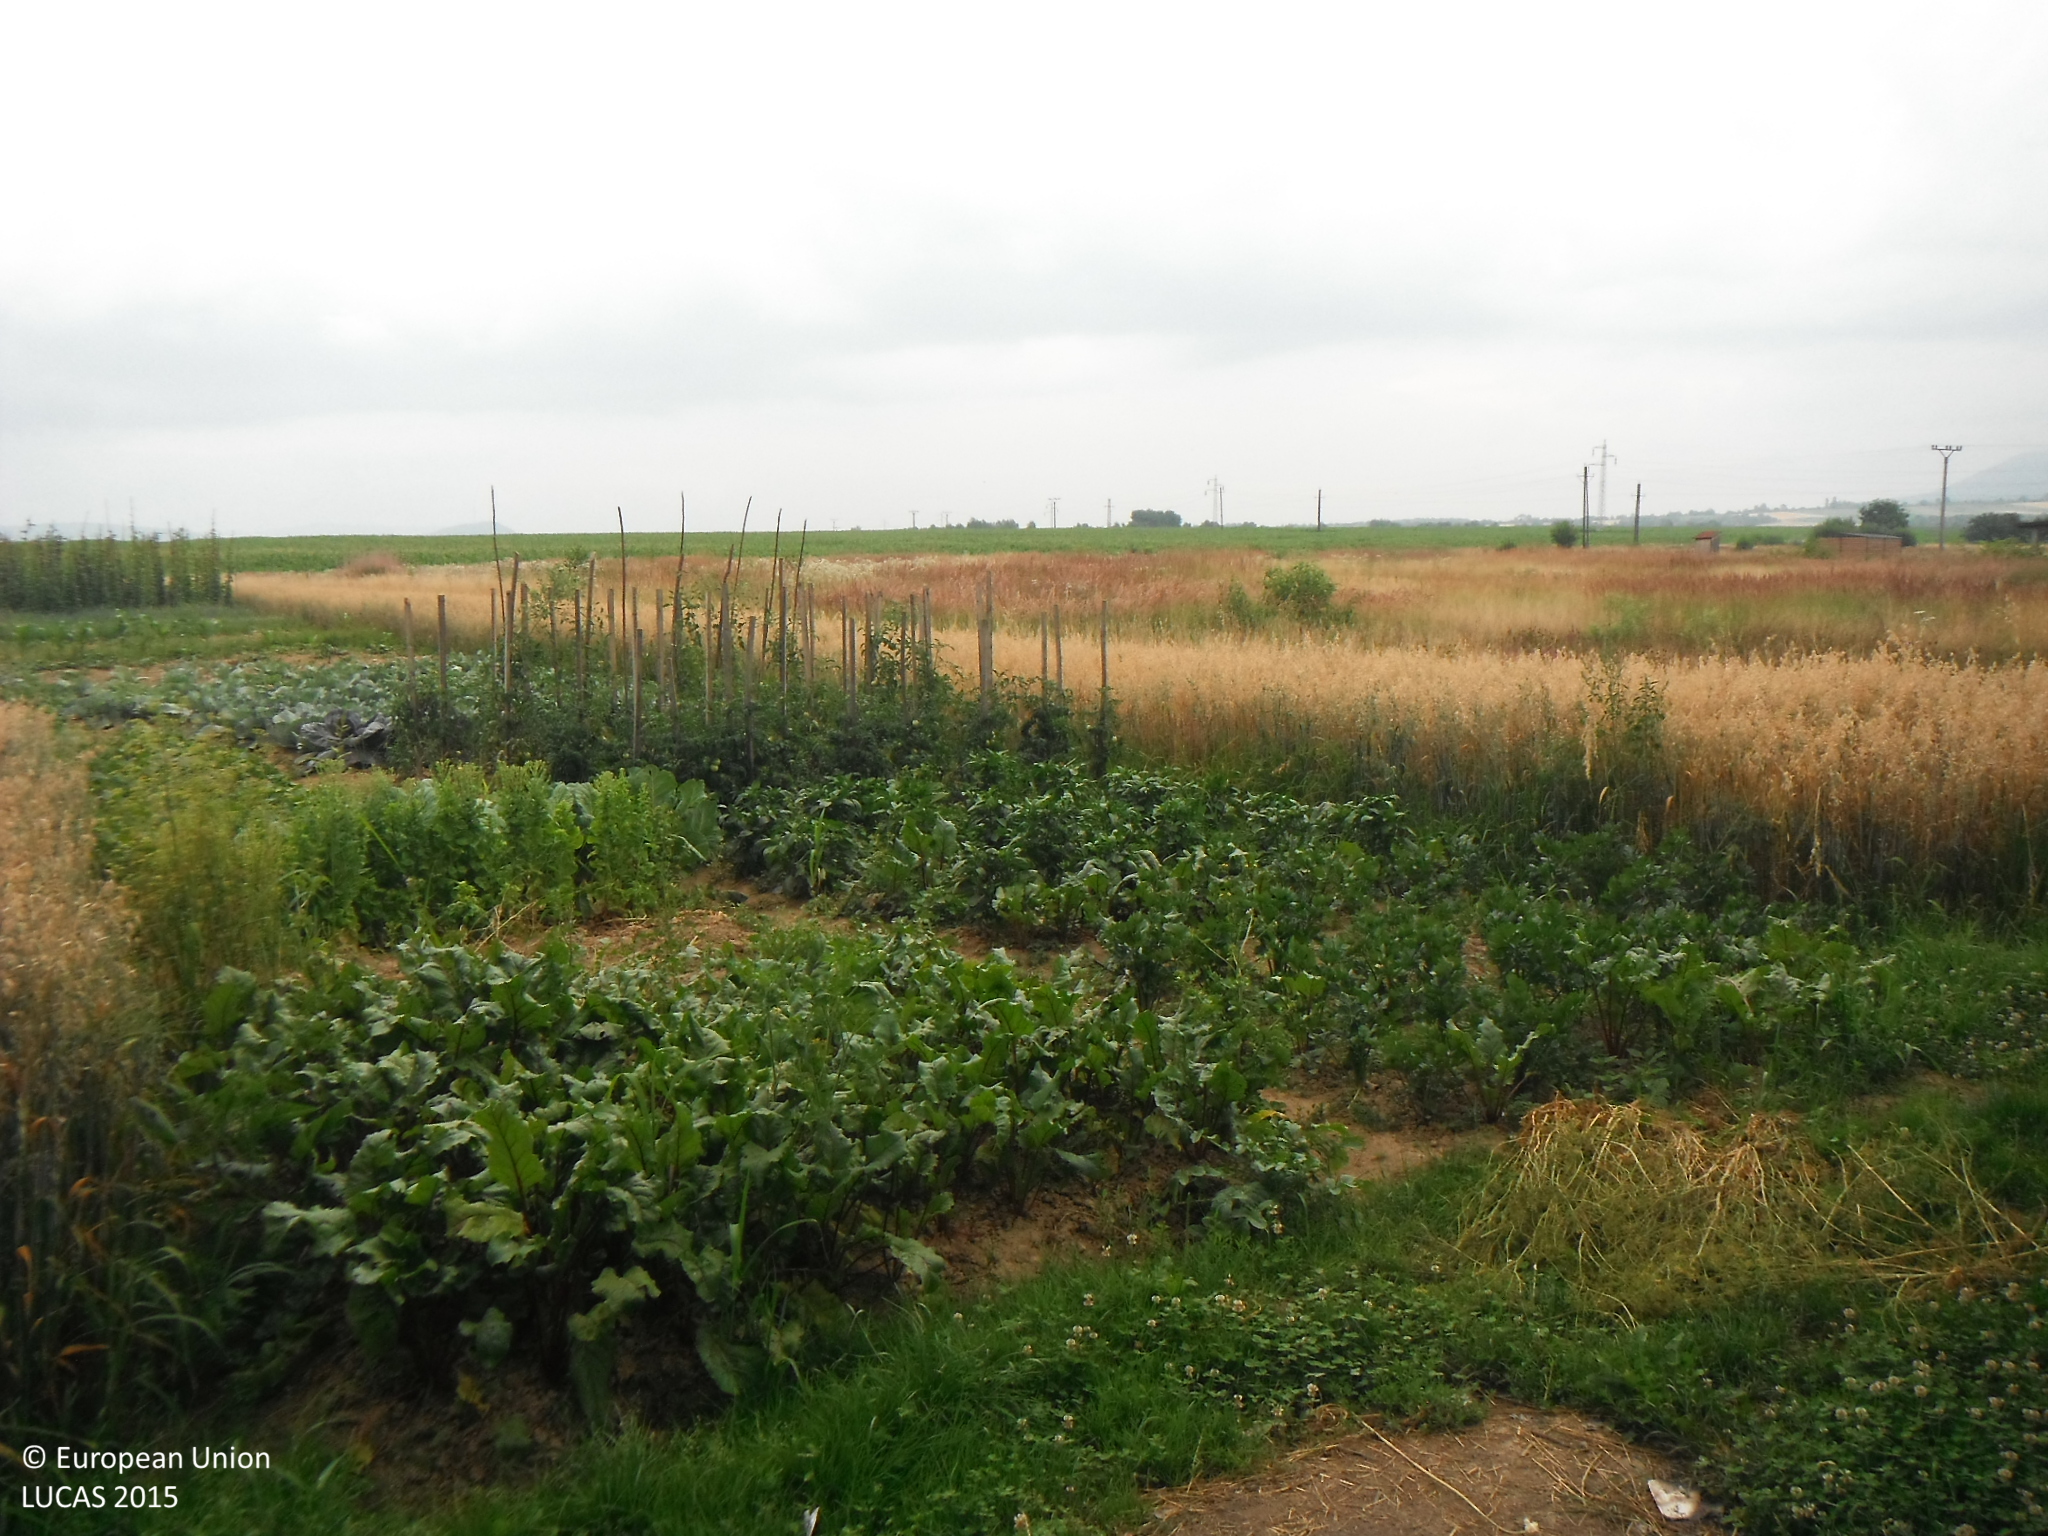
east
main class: Cropland
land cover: Nuts trees
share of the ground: > 75 %
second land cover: Grassland without tree/shrub cover
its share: > 75 %
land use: Kitchen garden
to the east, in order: Nuts trees; Grassland without tree/shrub cover; Fences; Other fresh vegetables; Oats; Spontaneously vegetated surfaces; Barley; Spontaneously vegetated surfaces; Common wheat; Spontaneously vegetated surfaces; Grassland without tree/shrub cover; Potatoes; Grassland with sparse tree/shrub cover; Grassland without tree/shrub cover; Maize; Tracks; Maize
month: July
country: SK
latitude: 48.9710
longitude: 22.1198
